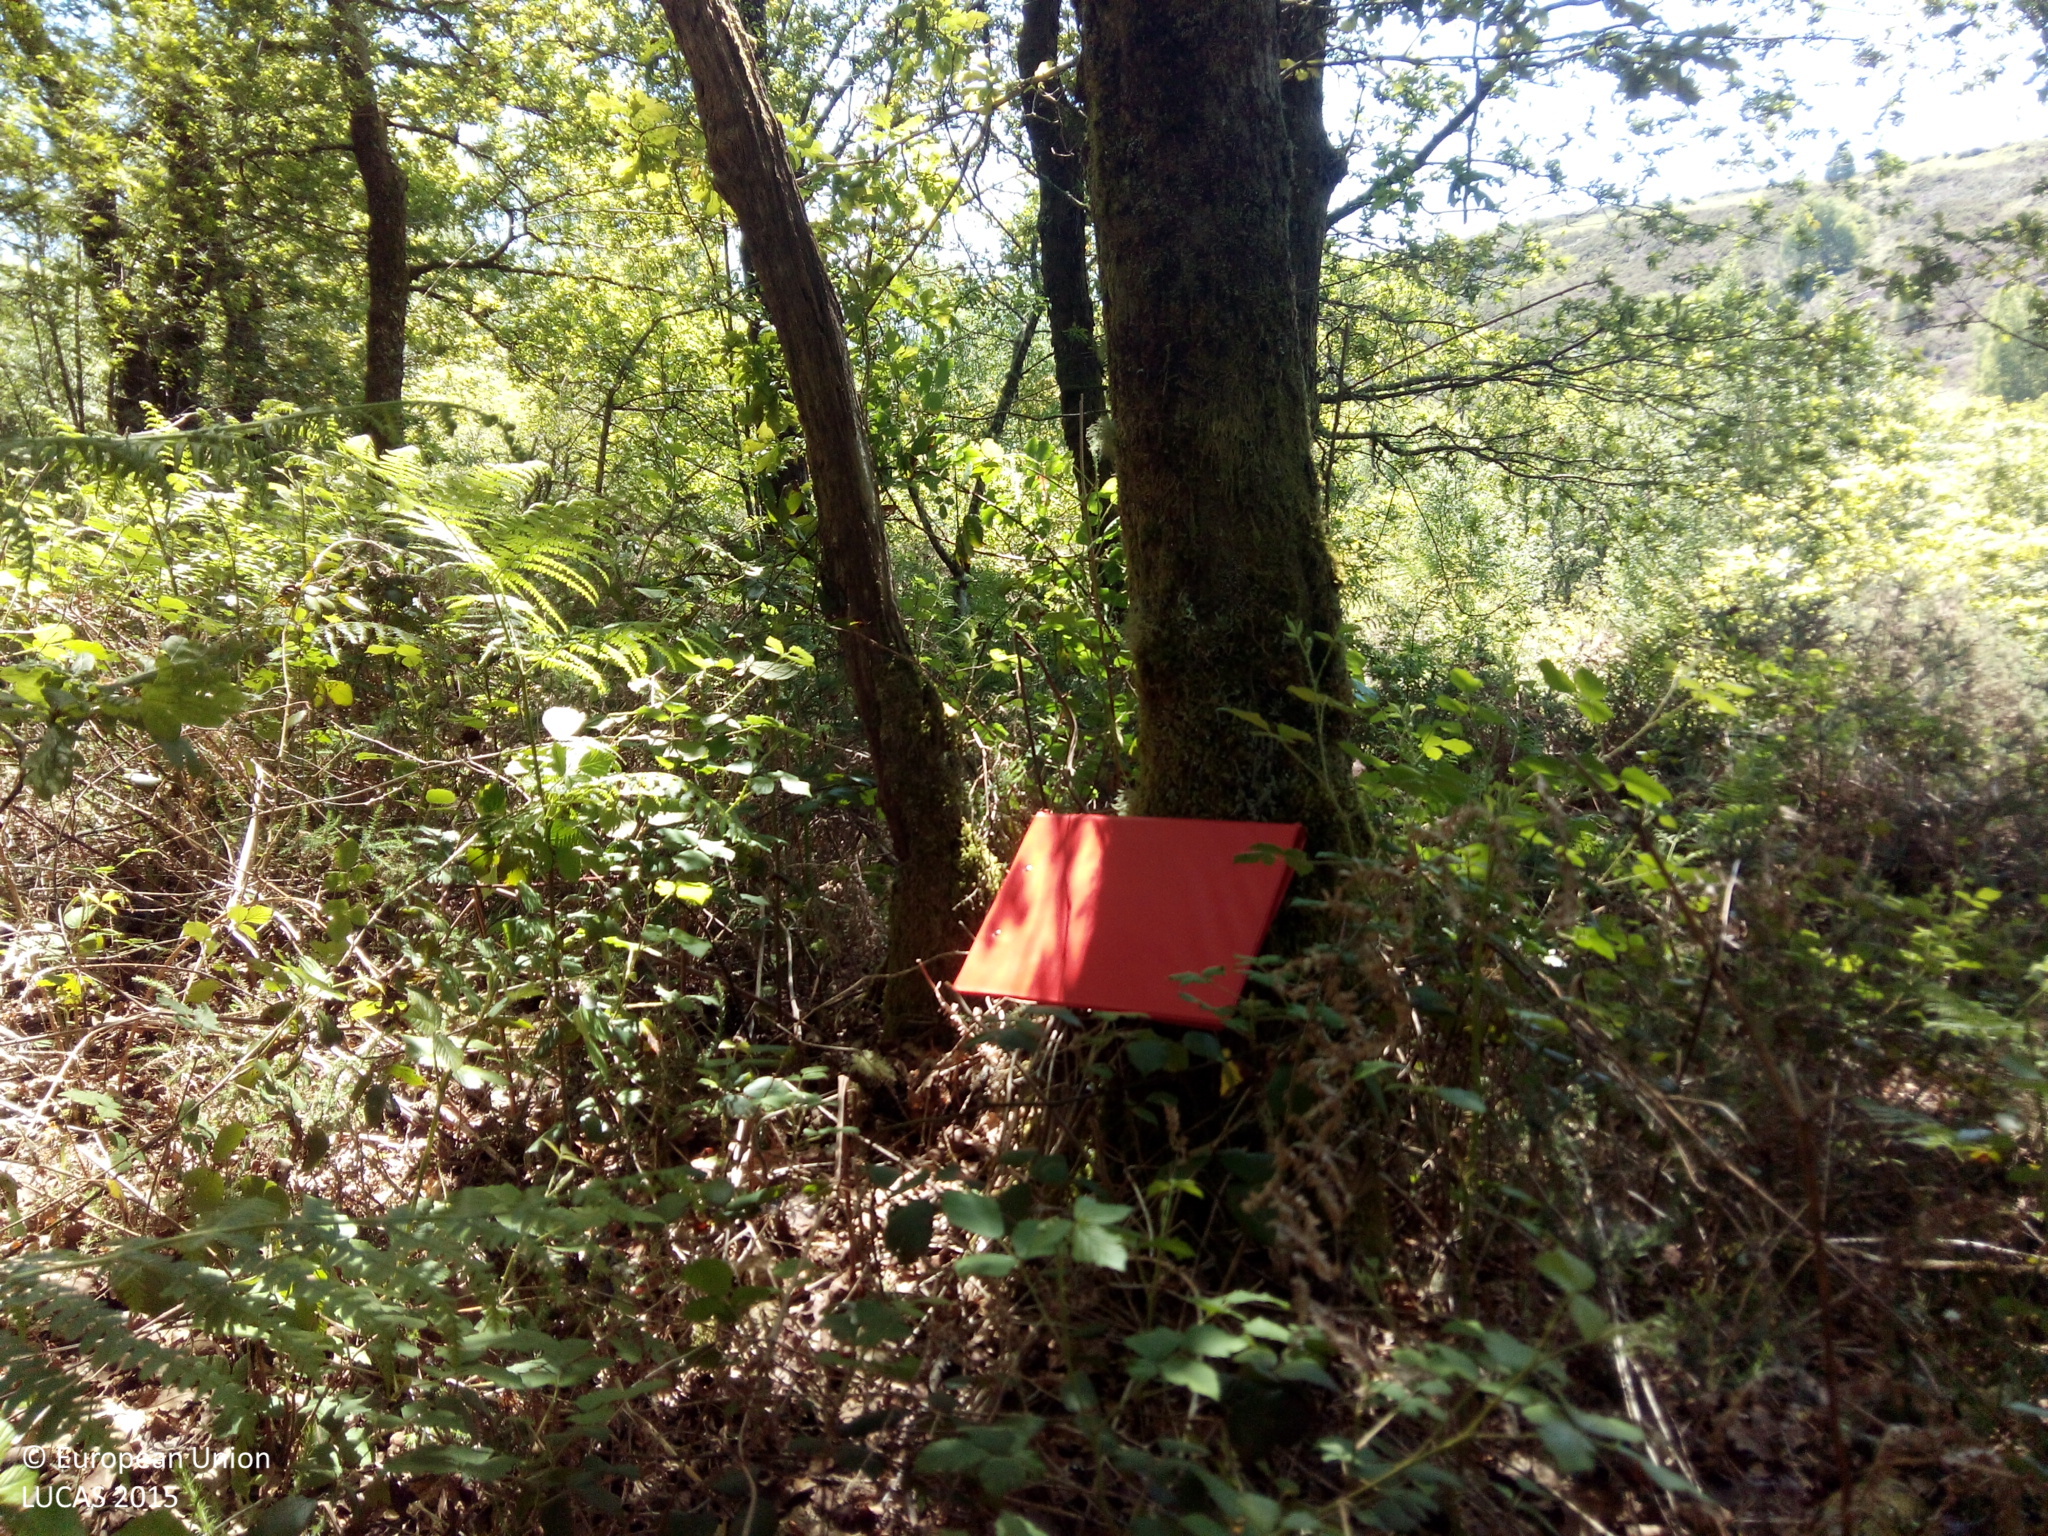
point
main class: Woodland
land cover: Broadleaved woodland
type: acidophilous oak and oak-birch forest
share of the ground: > 75 %
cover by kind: broadleaved forest trees 100 %
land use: Forestry
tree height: > 5 m
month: May
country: ES
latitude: 42.6015
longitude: -8.3657
